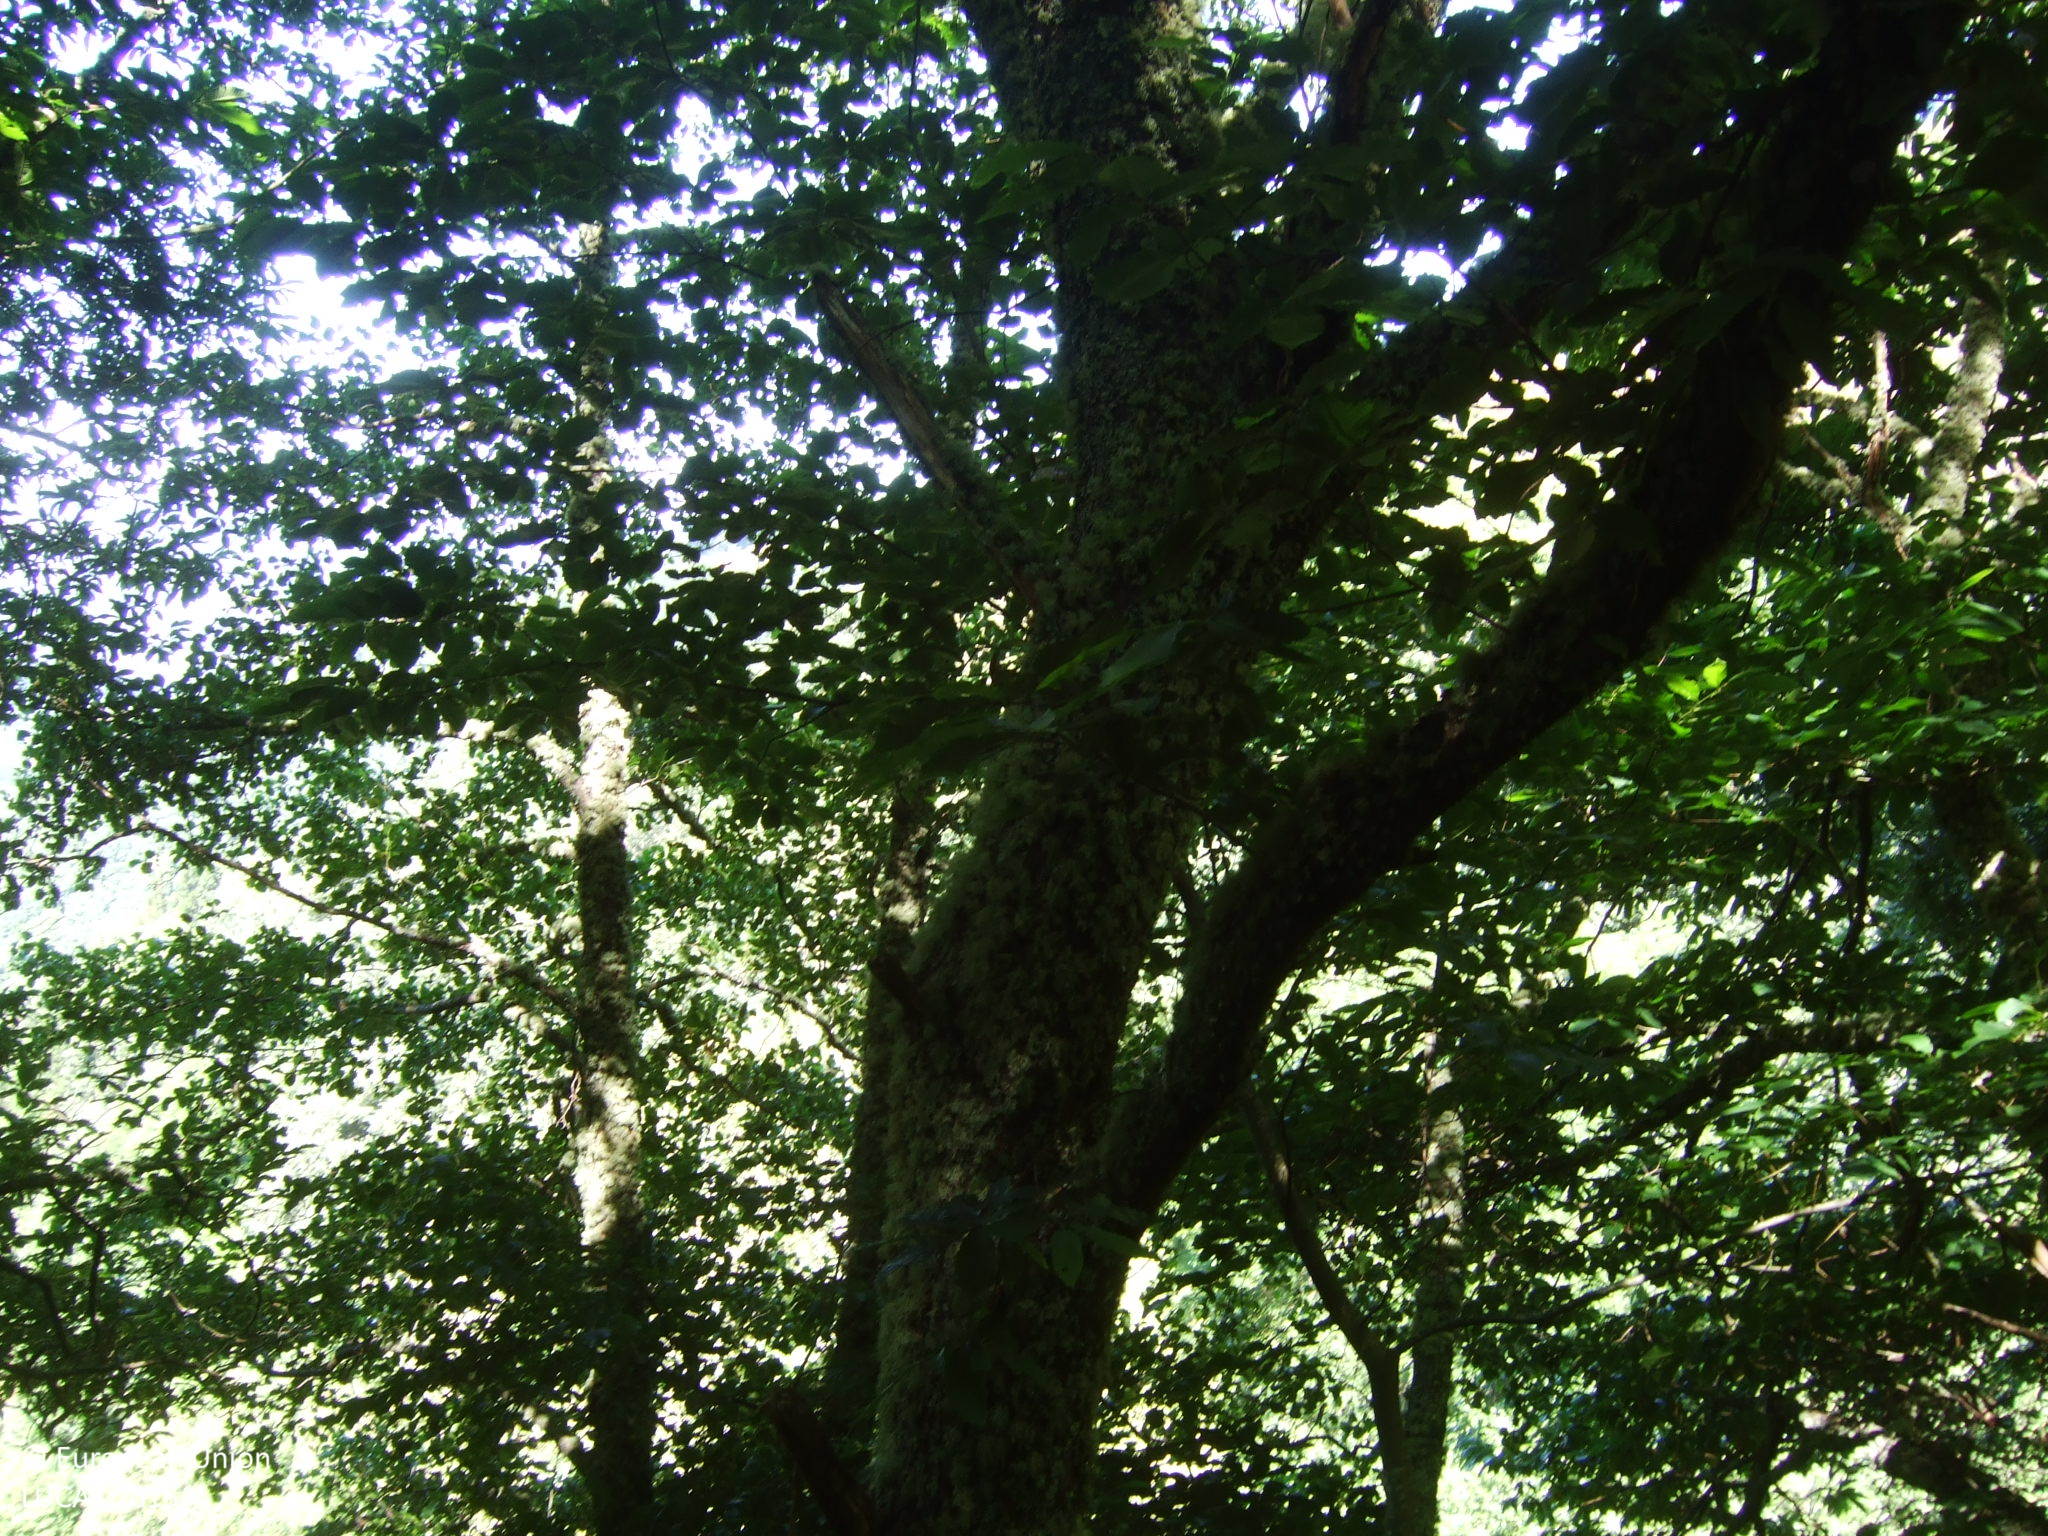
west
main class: Woodland
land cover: Broadleaved woodland
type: acidophilous oak and oak-birch forest
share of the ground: 50 - 75 %
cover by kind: broadleaved forest trees 70 %, shrubs 30 %
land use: Semi-natural and natural areas not in use
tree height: > 5 m
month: June
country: ES
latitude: 42.8246
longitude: -7.0013
